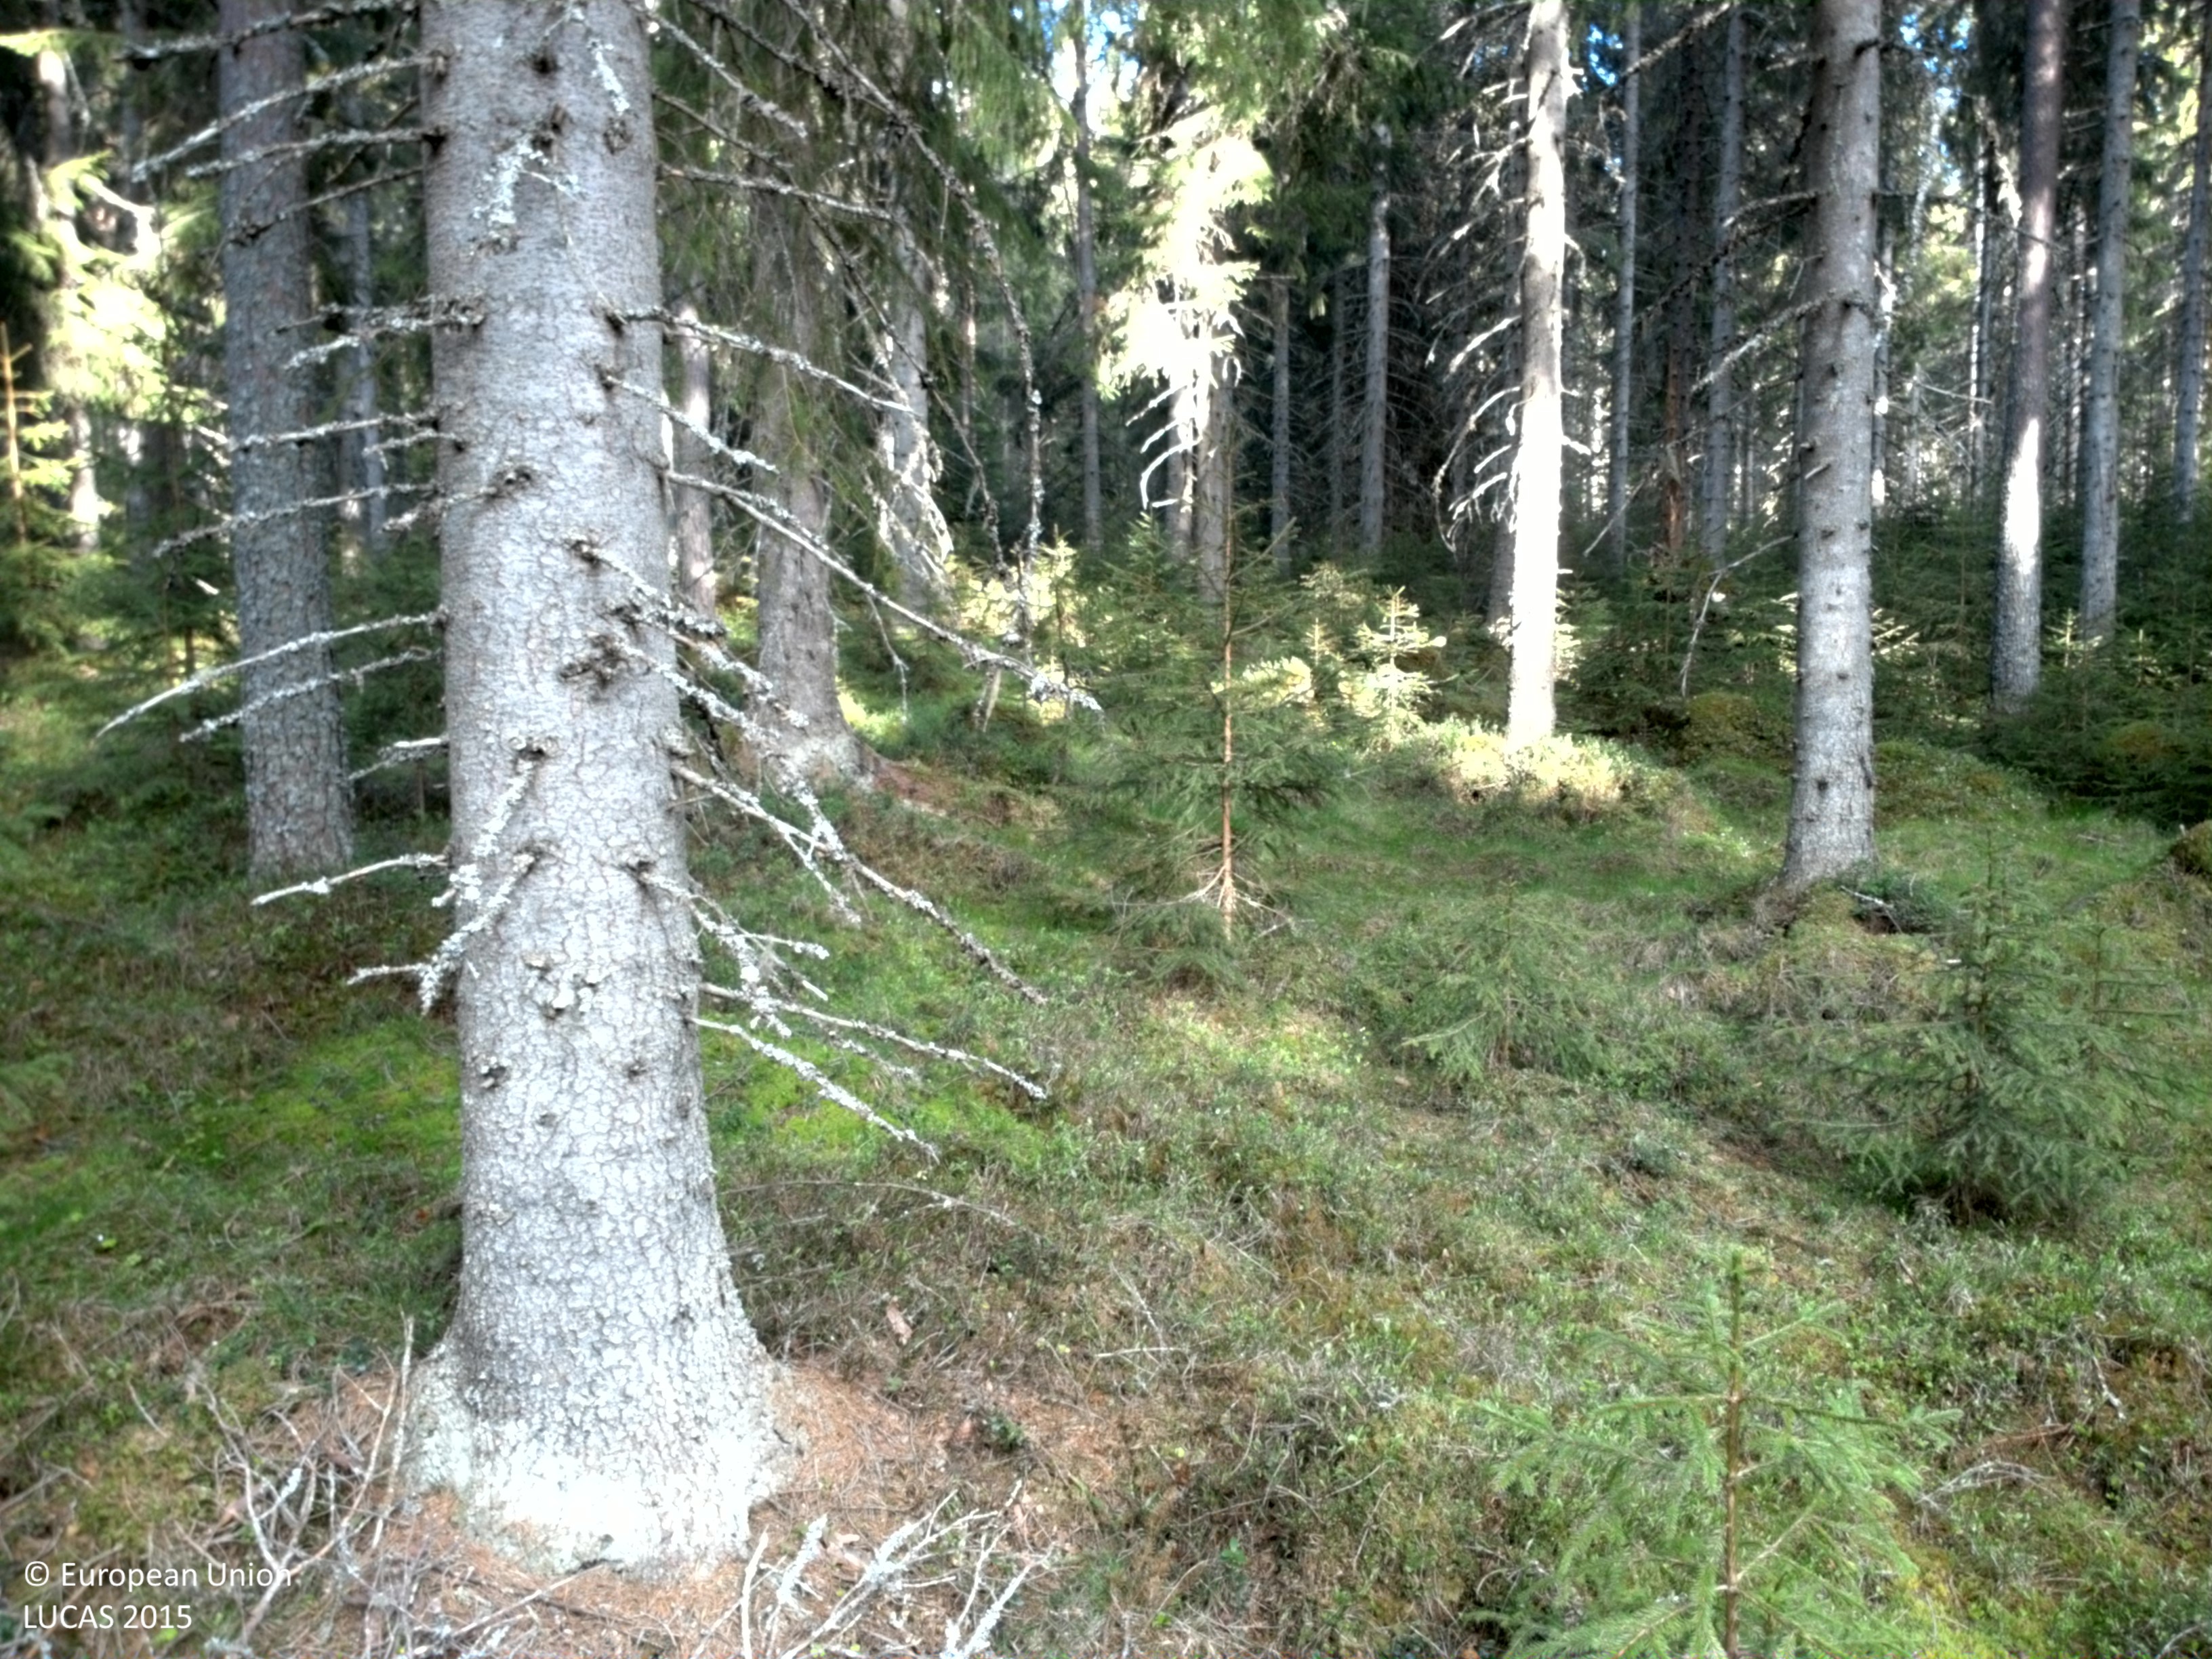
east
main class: Woodland
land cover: Spruce dominated coniferous woodland
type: boreal forest
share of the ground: > 75 %
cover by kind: coniferous forest trees 75 %, herbaceous plants 15 %, lichens and mosses 10 %
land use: Forestry
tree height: > 5 m
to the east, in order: Spruce dominated coniferous woodland; Ditches and canals; Spruce dominated coniferous woodland; Pine dominated coniferous woodland; Tracks; Shrubland without tree cover; Pine dominated coniferous woodland; Tracks; Pine dominated coniferous woodland
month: May
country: SE
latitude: 61.1561
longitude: 15.0213
